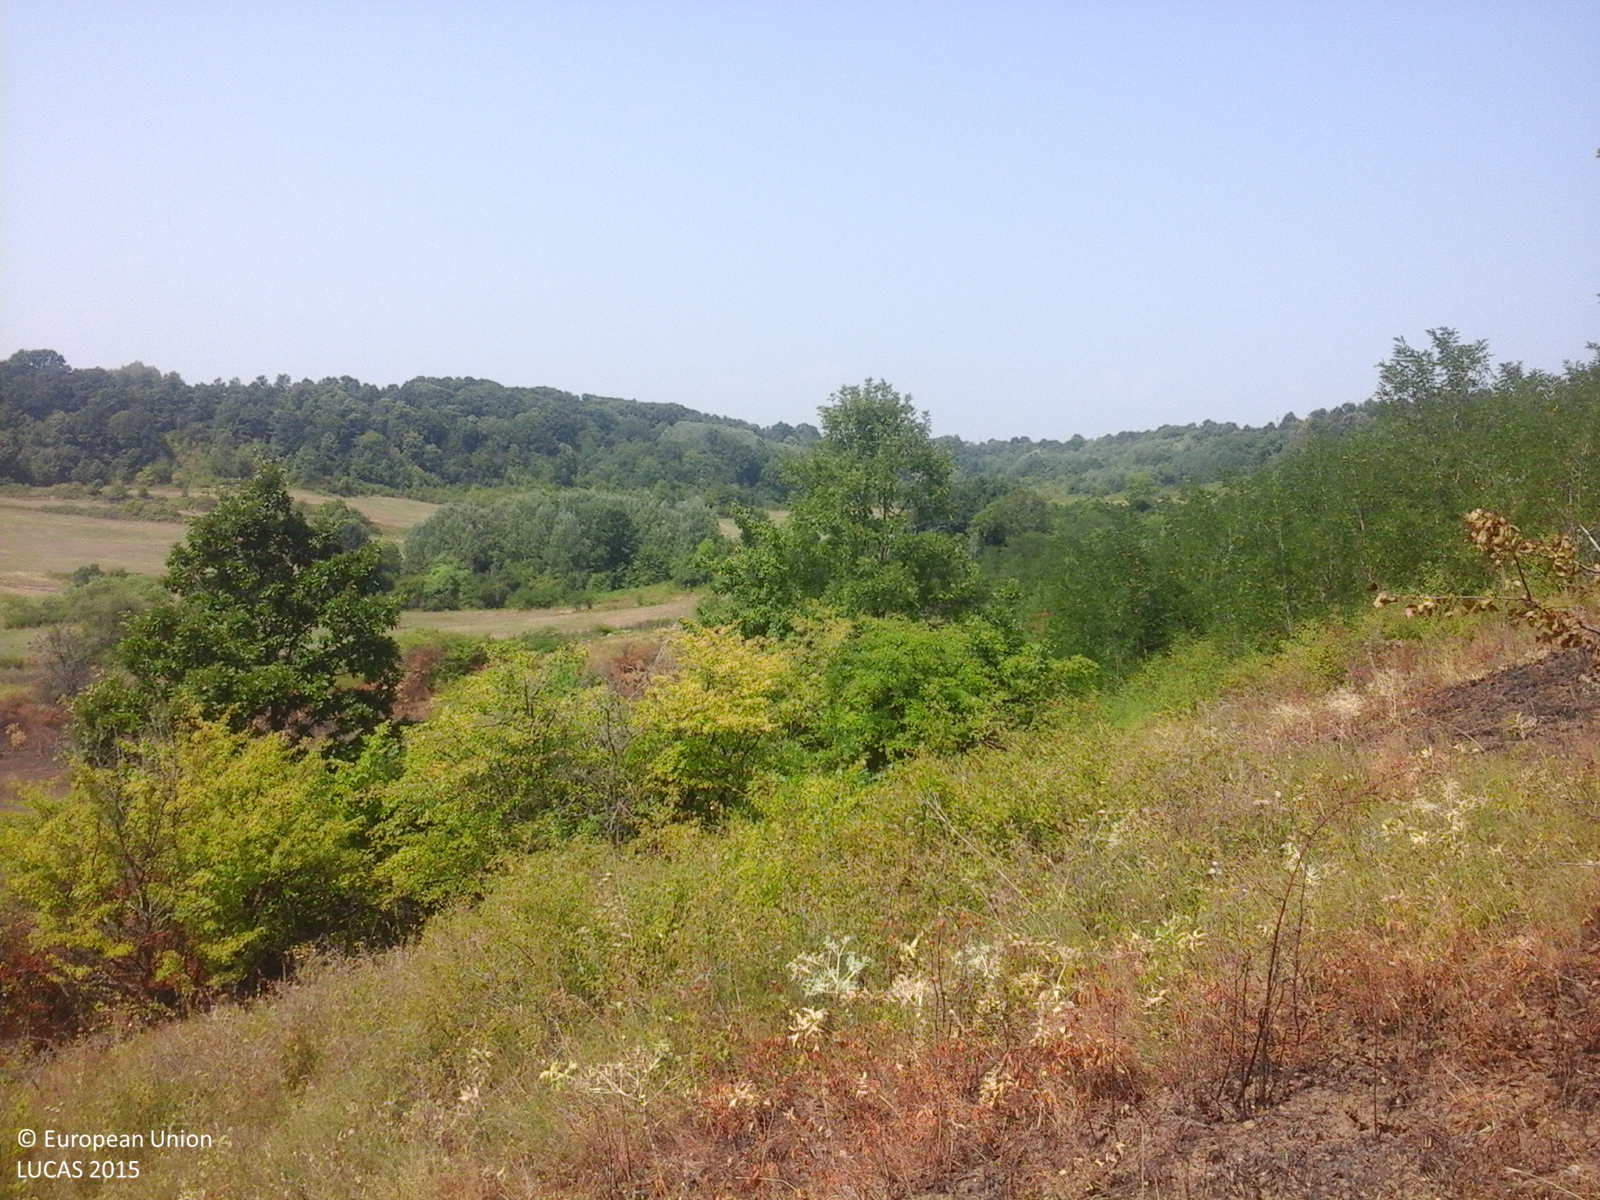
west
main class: Grassland
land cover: Grassland with sparse tree/shrub cover
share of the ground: > 75 %
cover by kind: herbaceous plants 85 %, shrubs 10 %, broadleaved forest trees 5 %
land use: Agriculture (excluding fallow land and kitchen gardens)
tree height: < 5 m
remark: Burnt area
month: August
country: RO
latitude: 44.5206
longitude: 23.0940
